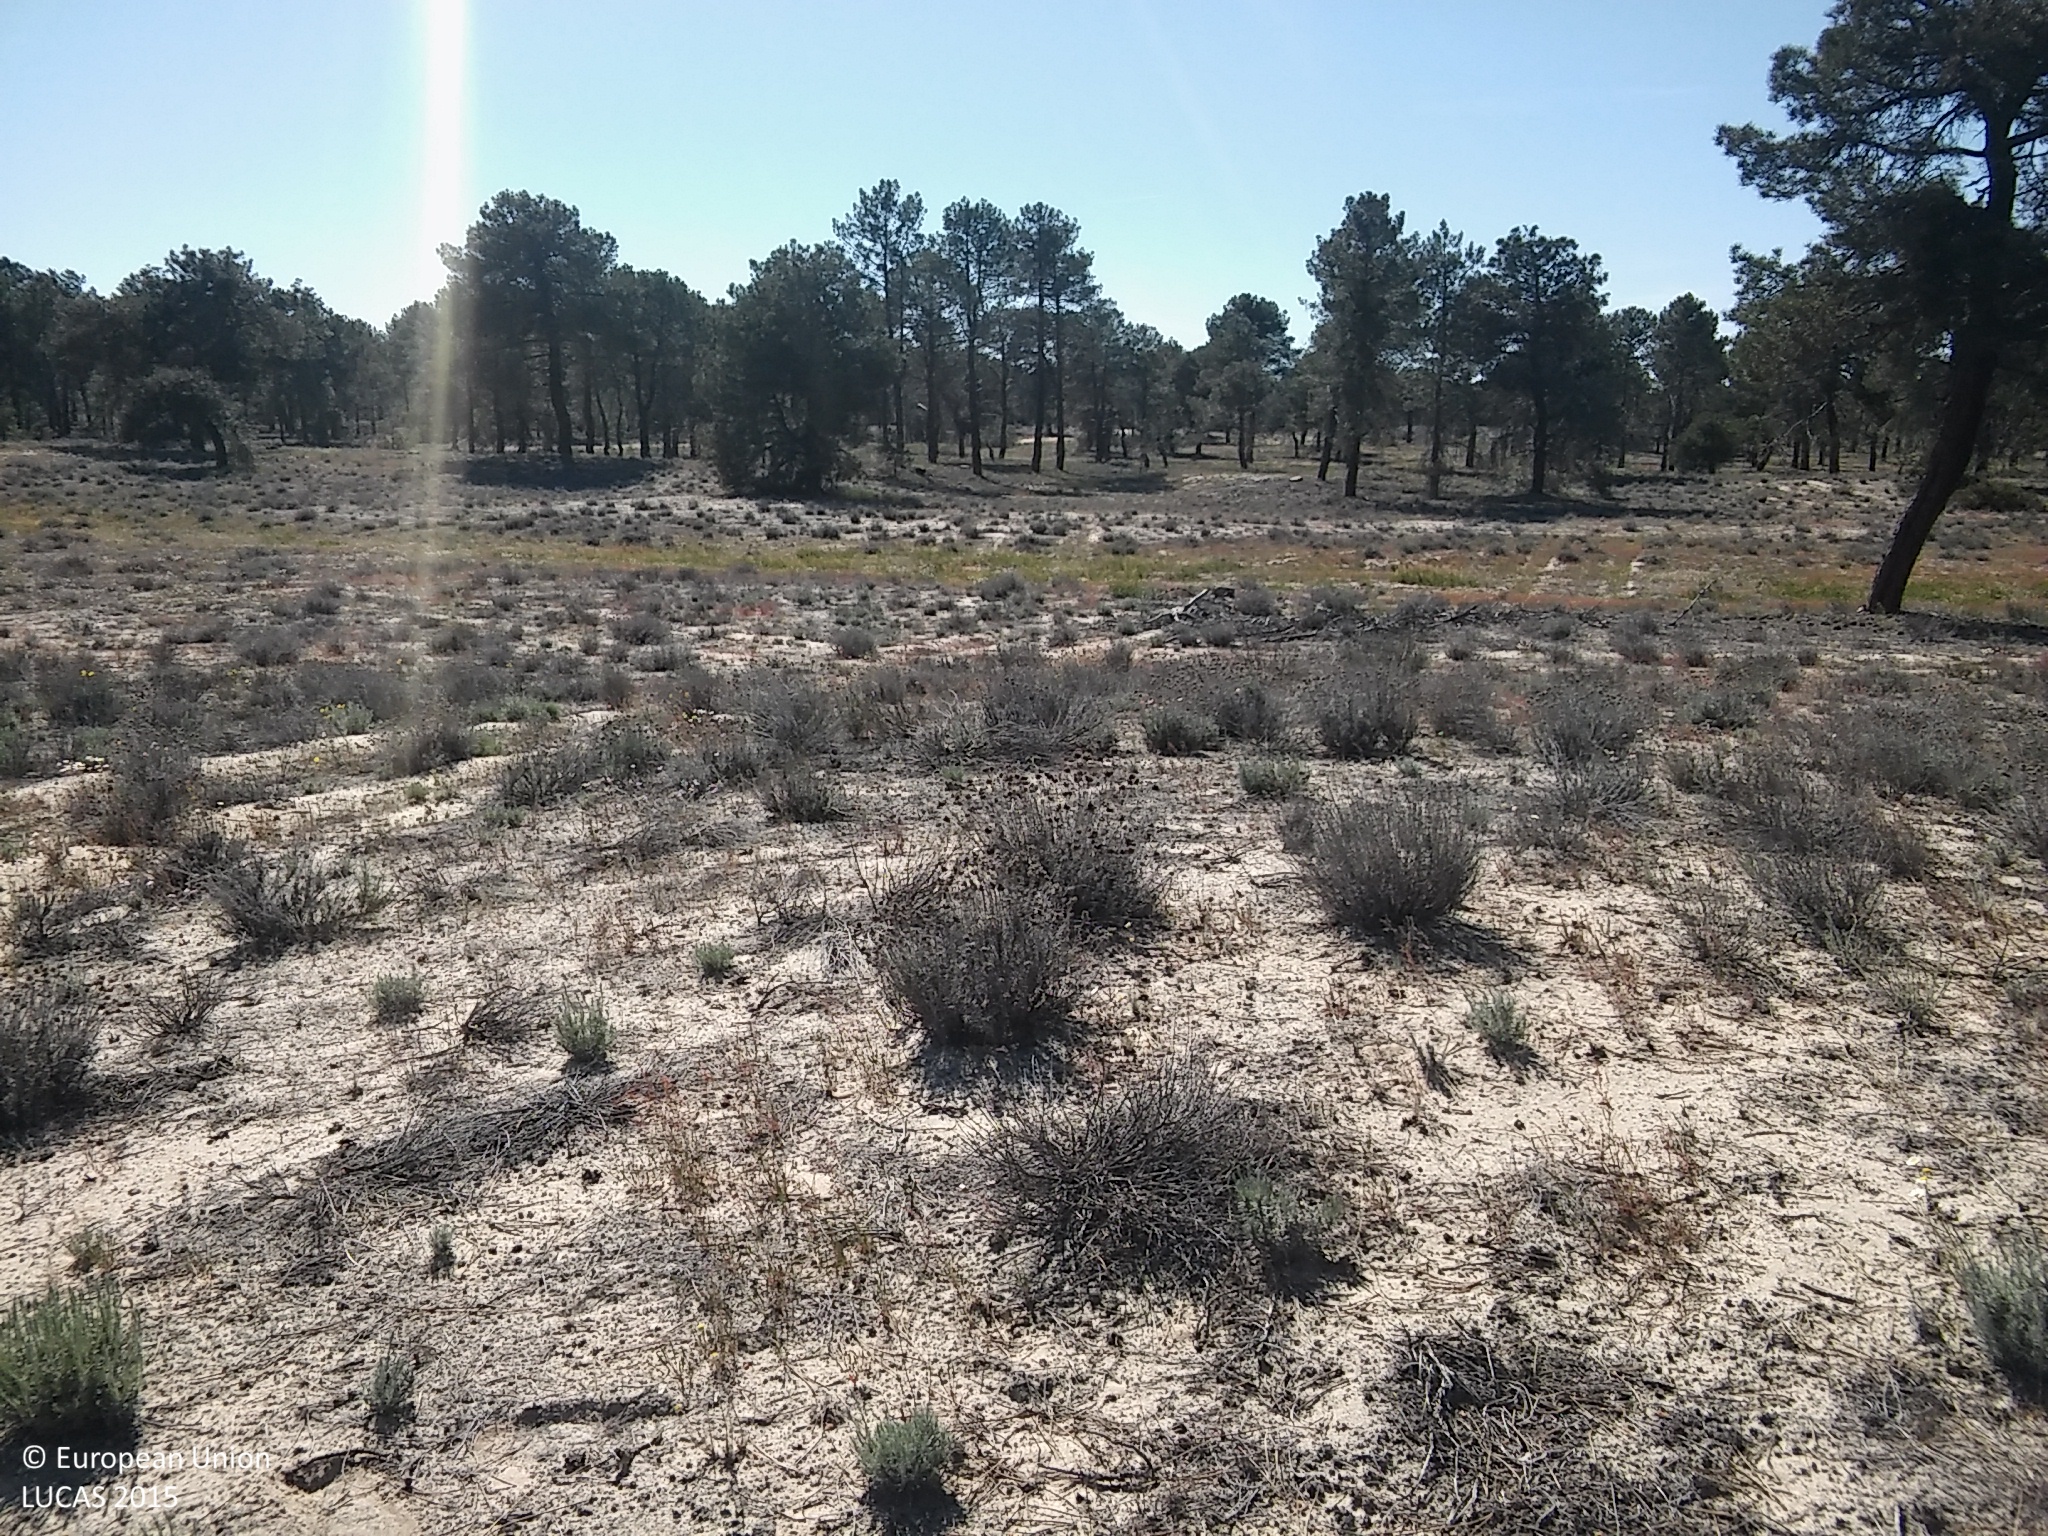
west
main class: Shrubland
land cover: Shrubland with sparse tree cover
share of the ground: 10 - 25 %
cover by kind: unconsolidated bare surface 80 %, shrubs 10 %, coniferous forest trees 5 %, herbaceous plants 5 %
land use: Forestry
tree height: > 5 m
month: May
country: ES
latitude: 41.3610
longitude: -4.0283
